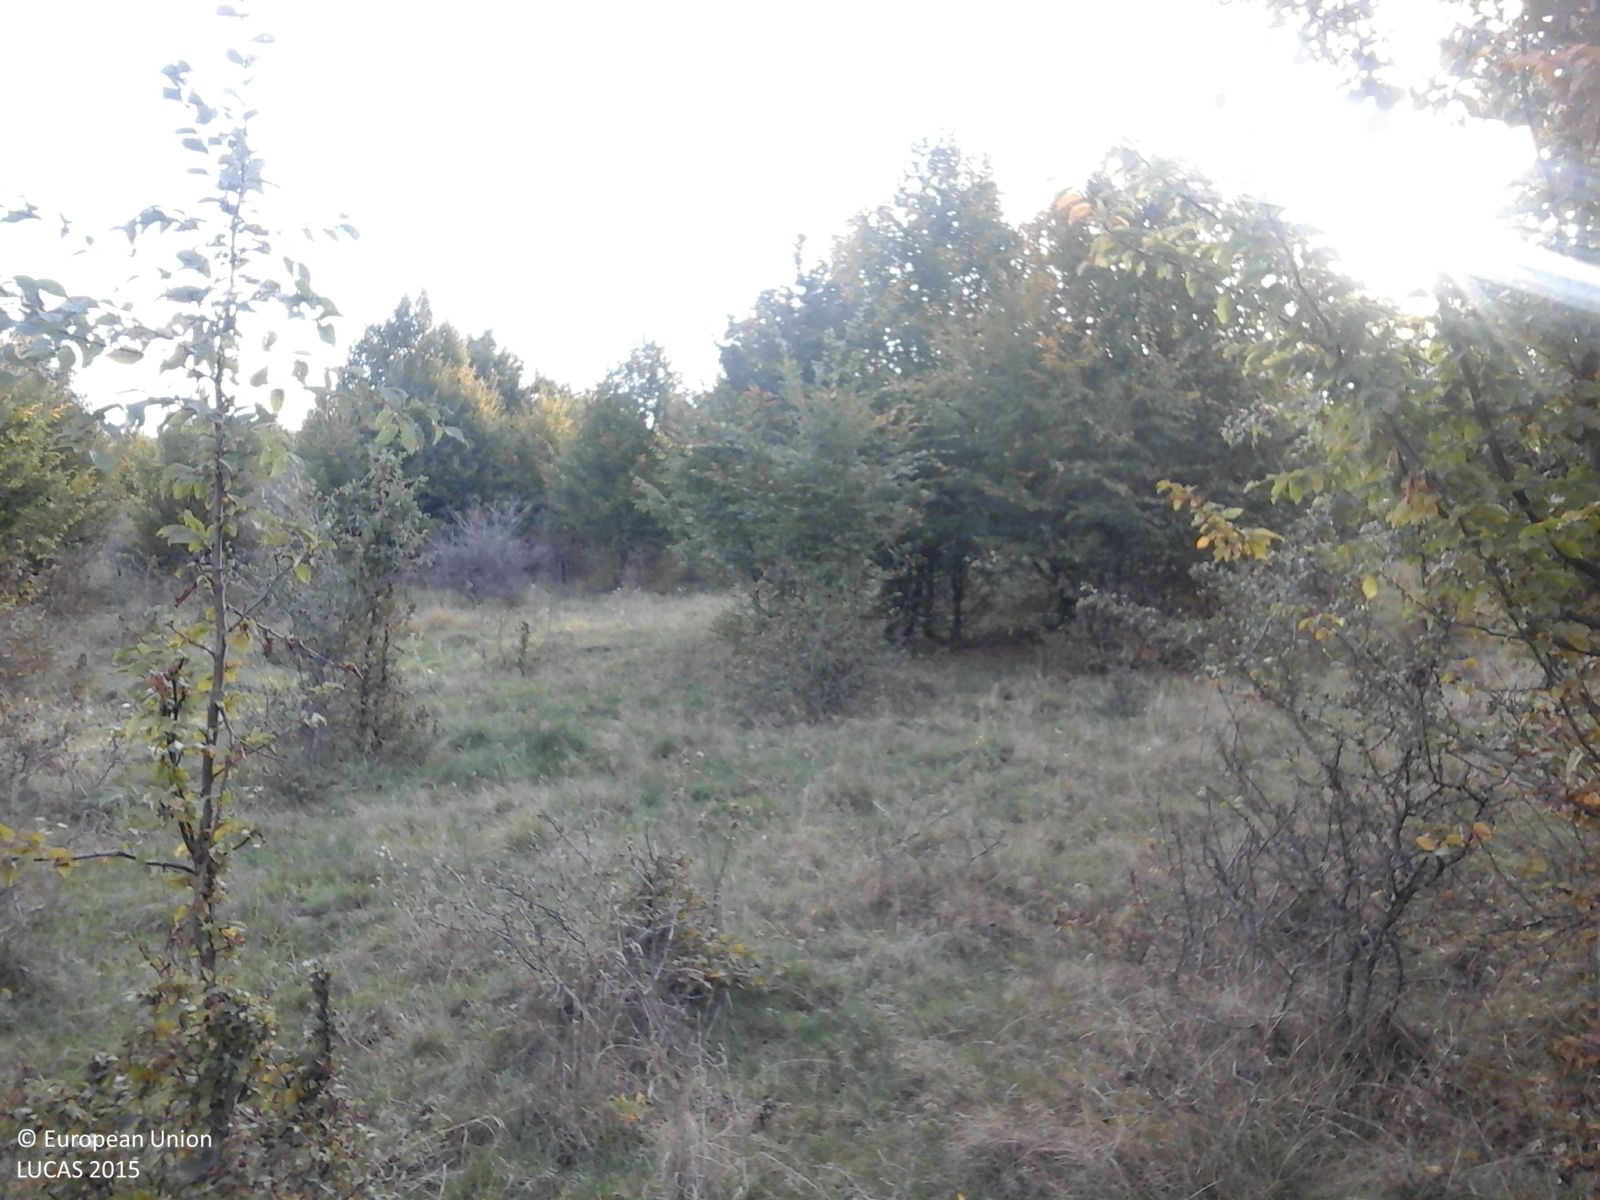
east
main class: Grassland
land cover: Grassland with sparse tree/shrub cover
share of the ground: > 75 %
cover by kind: herbaceous plants 85 %, shrubs 10 %, broadleaved forest trees 5 %
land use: Fallow land
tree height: < 5 m
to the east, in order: Grassland with sparse tree/shrub cover; Grassland without tree/shrub cover; Grassland with sparse tree/shrub cover
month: October
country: RO
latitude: 46.2020
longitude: 25.2507
